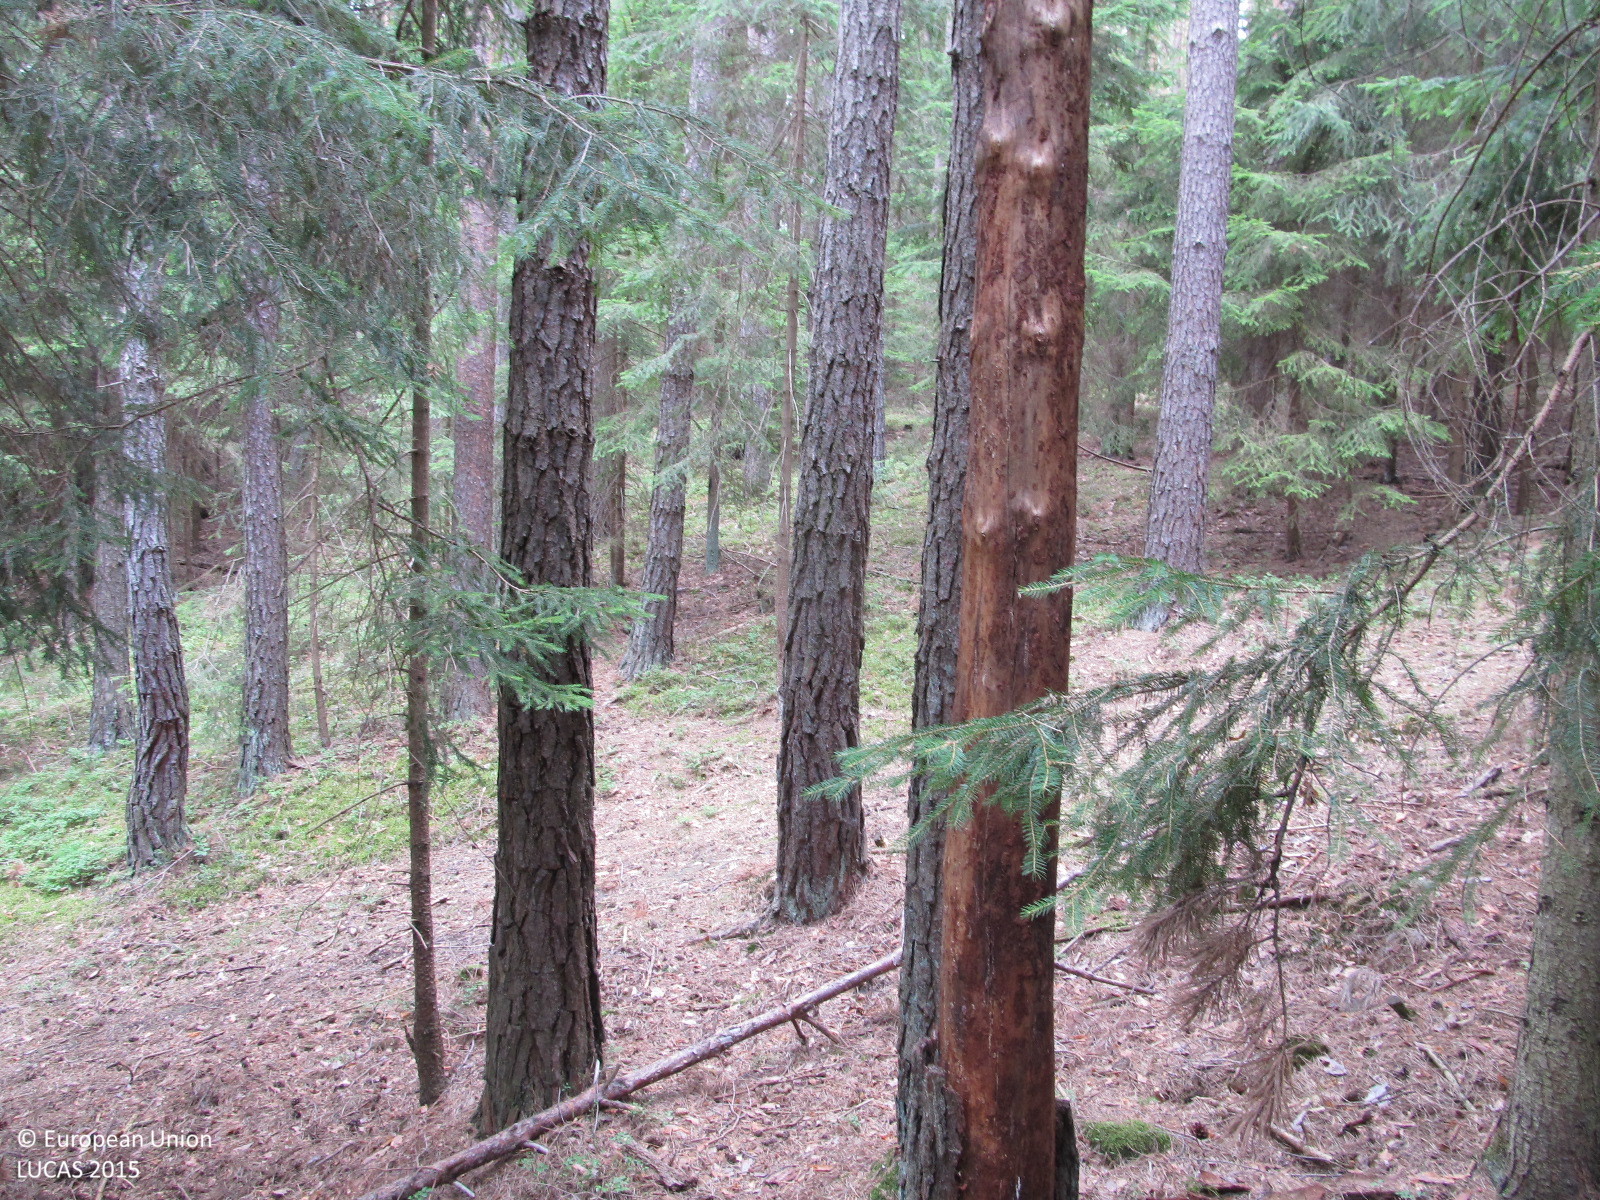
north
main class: Woodland
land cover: Other coniferous woodland
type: hemiboreal forest and nemoral coniferous forest and mixed broadleaved-coniferous forest
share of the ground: > 75 %
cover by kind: coniferous forest trees 80 %, lichens and mosses 10 %, herbaceous plants 5 %, unconsolidated bare surface 5 %
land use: Forestry
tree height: > 5 m
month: July
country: AT
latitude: 48.5930
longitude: 15.0863
